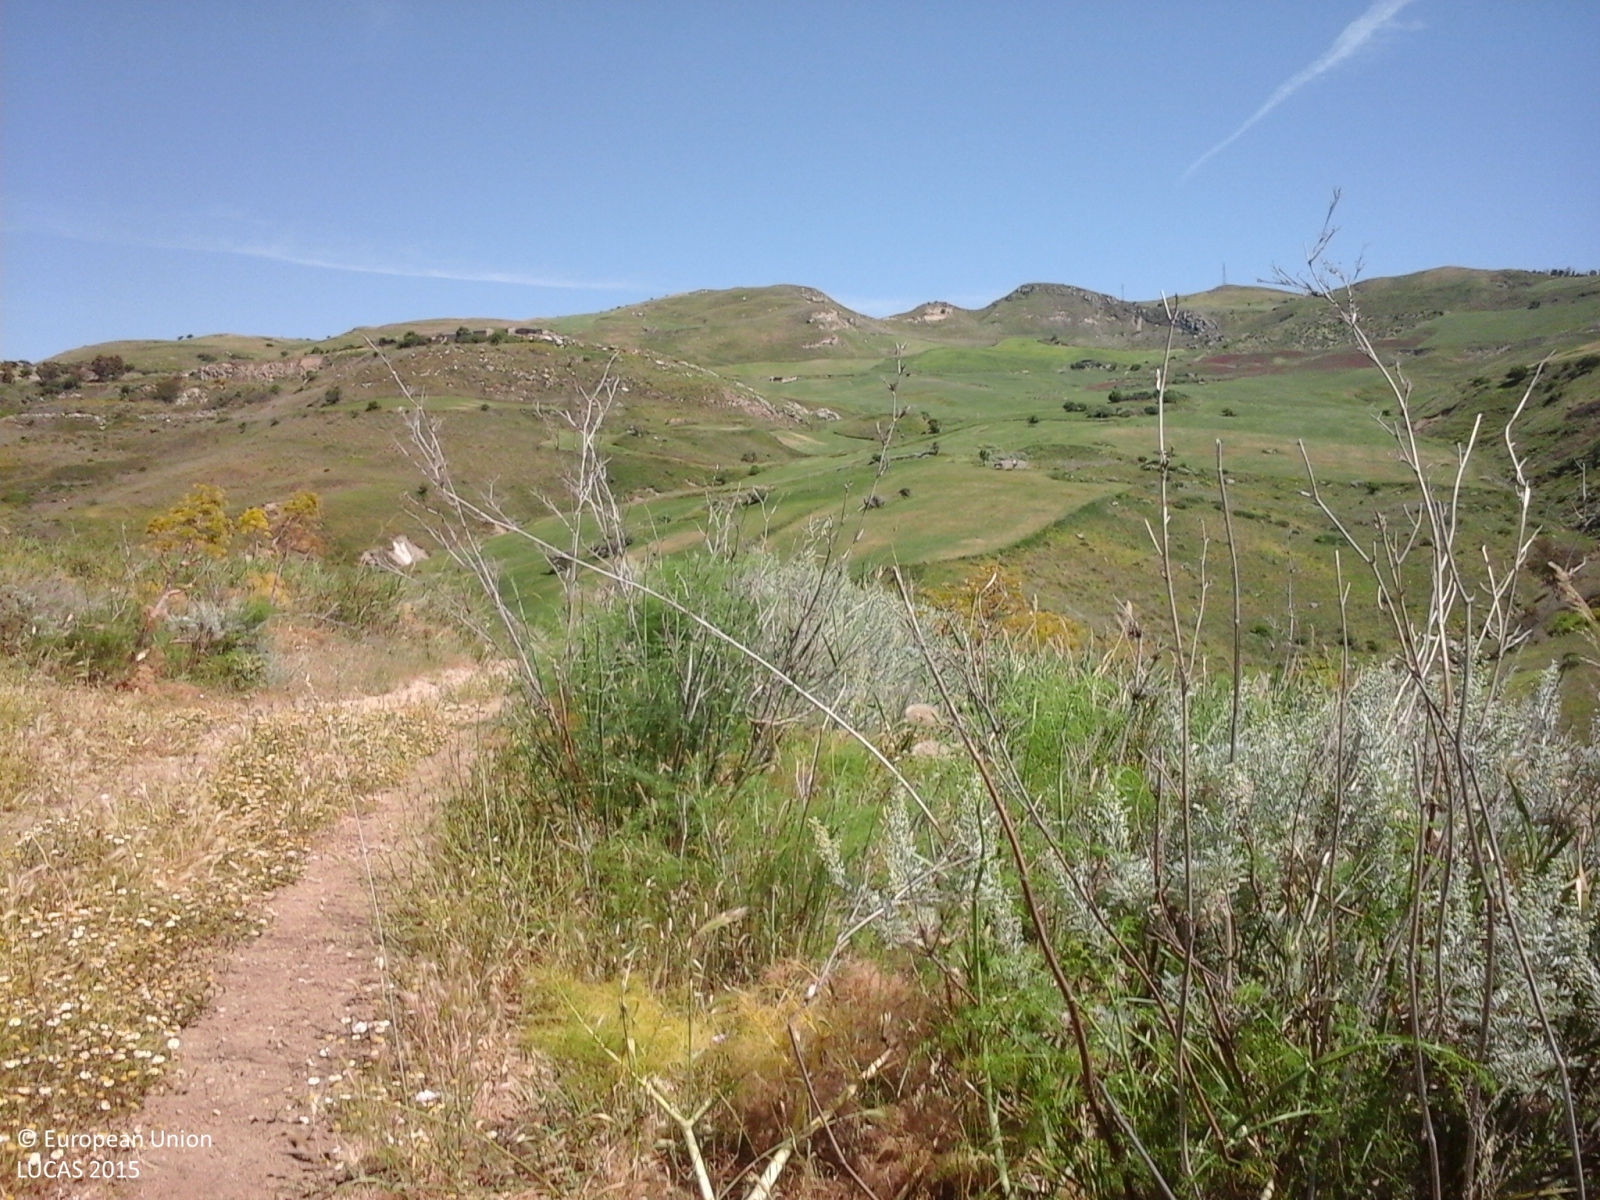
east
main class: Grassland
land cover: Grassland without tree/shrub cover
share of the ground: > 75 %
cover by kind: herbaceous plants 100 %
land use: Agriculture (excluding fallow land and kitchen gardens)
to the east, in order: Grassland without tree/shrub cover; Temporary grasslands; Grassland without tree/shrub cover
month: May
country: IT
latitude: 37.5911
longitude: 13.9910
